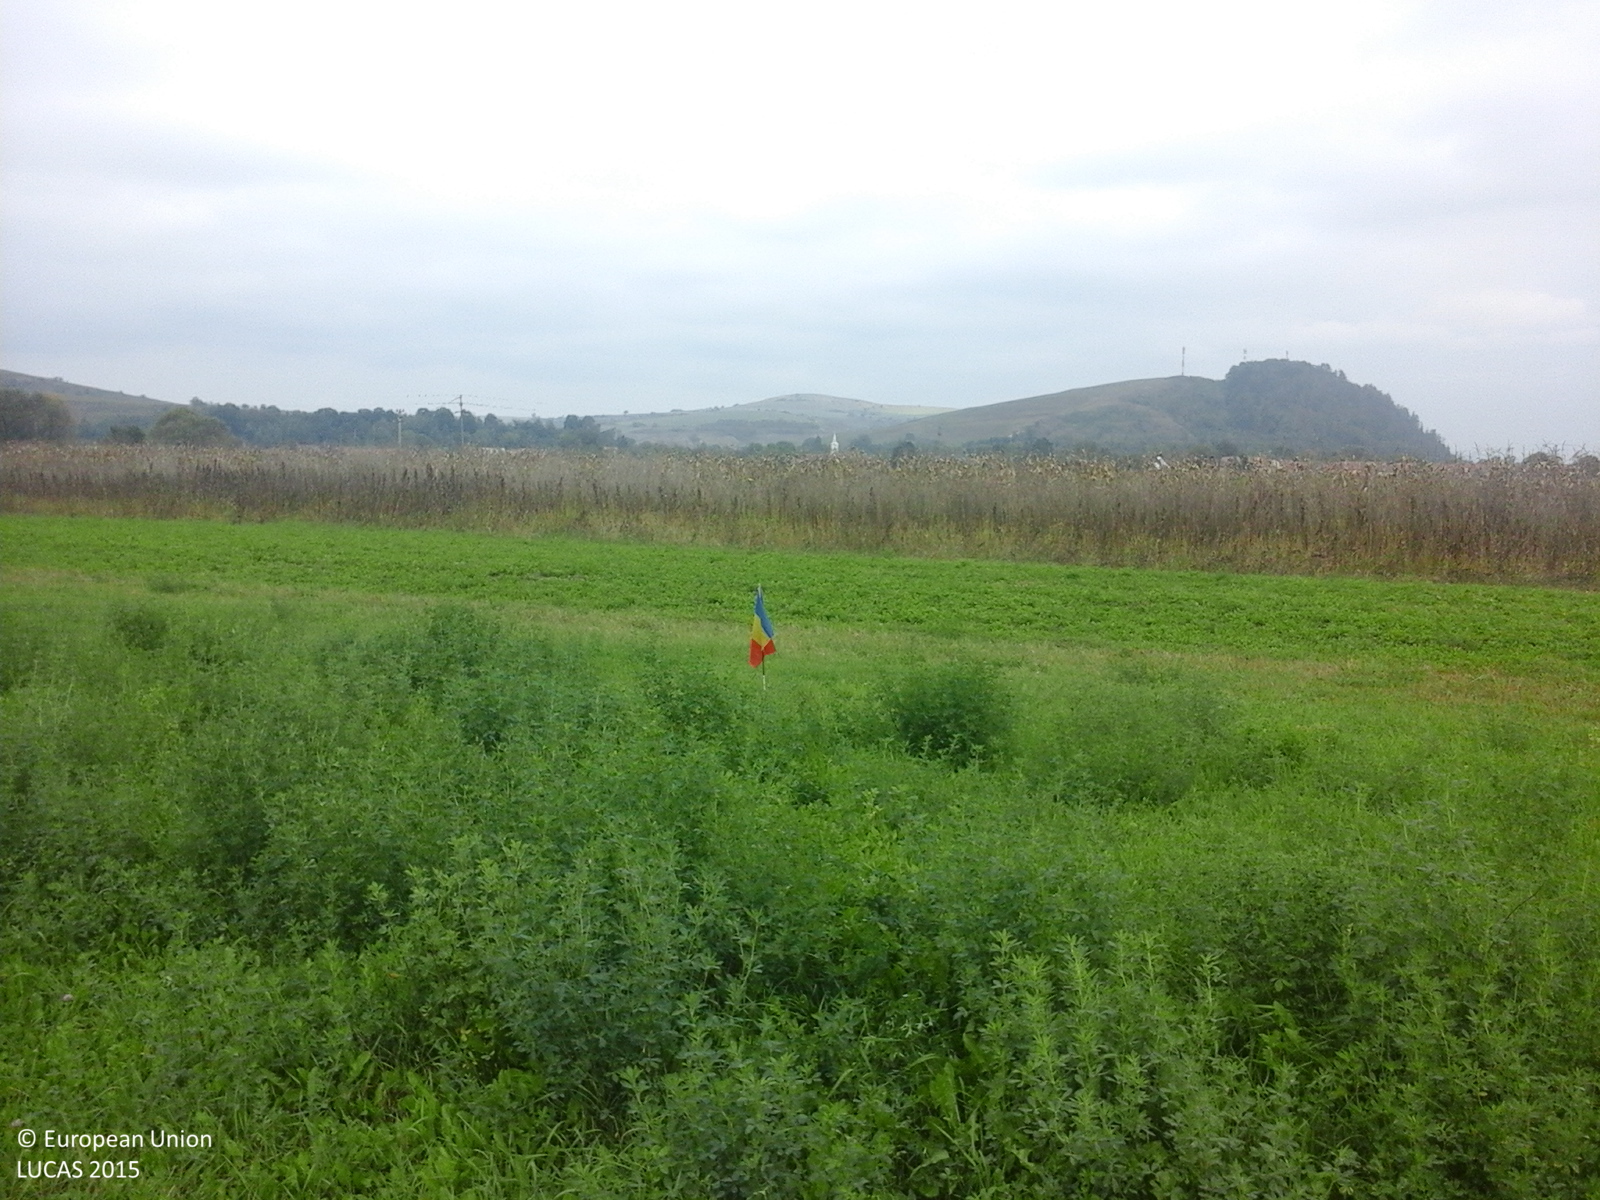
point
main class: Cropland
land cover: Other leguminous and mixtures for fodder
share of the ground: > 75 %
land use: Agriculture (excluding fallow land and kitchen gardens)
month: October
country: RO
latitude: 45.9170
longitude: 25.1953
